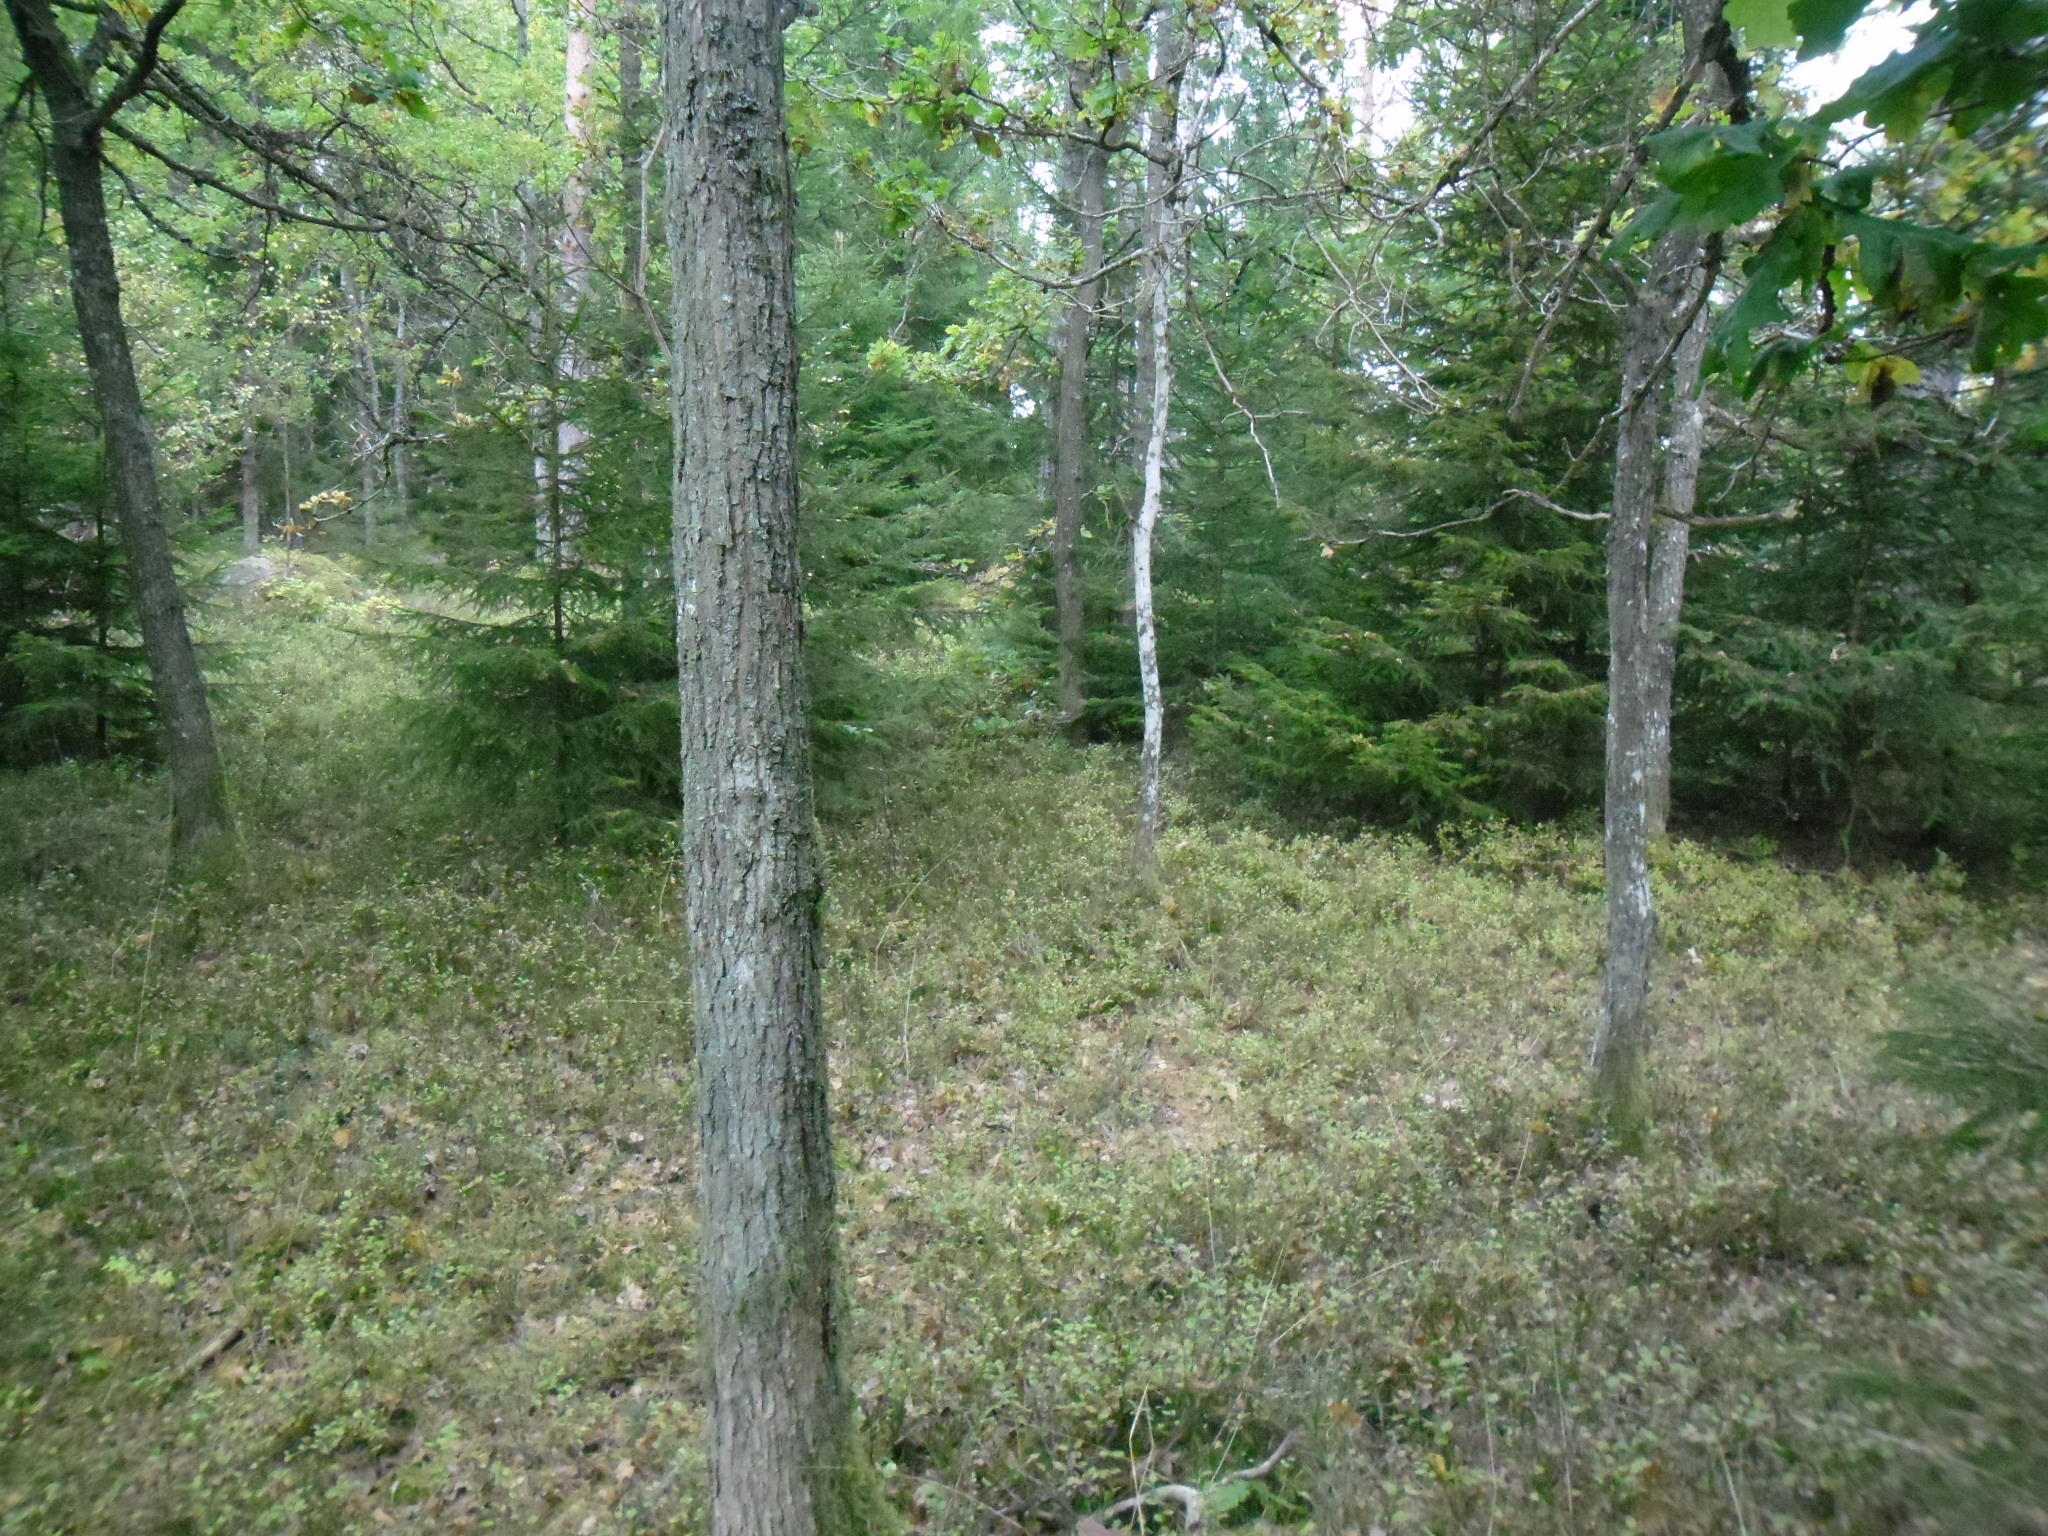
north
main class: Woodland
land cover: Spruce dominated mixed woodland
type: hemiboreal forest and nemoral coniferous forest and mixed broadleaved-coniferous forest
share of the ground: 50 - 75 %
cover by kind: coniferous forest trees 45 %, shrubs 30 %, broadleaved forest trees 15 %, herbaceous plants 10 %
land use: Forestry
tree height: > 5 m
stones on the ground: 25 - 50 %
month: October
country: SE
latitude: 56.3655
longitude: 13.8014
